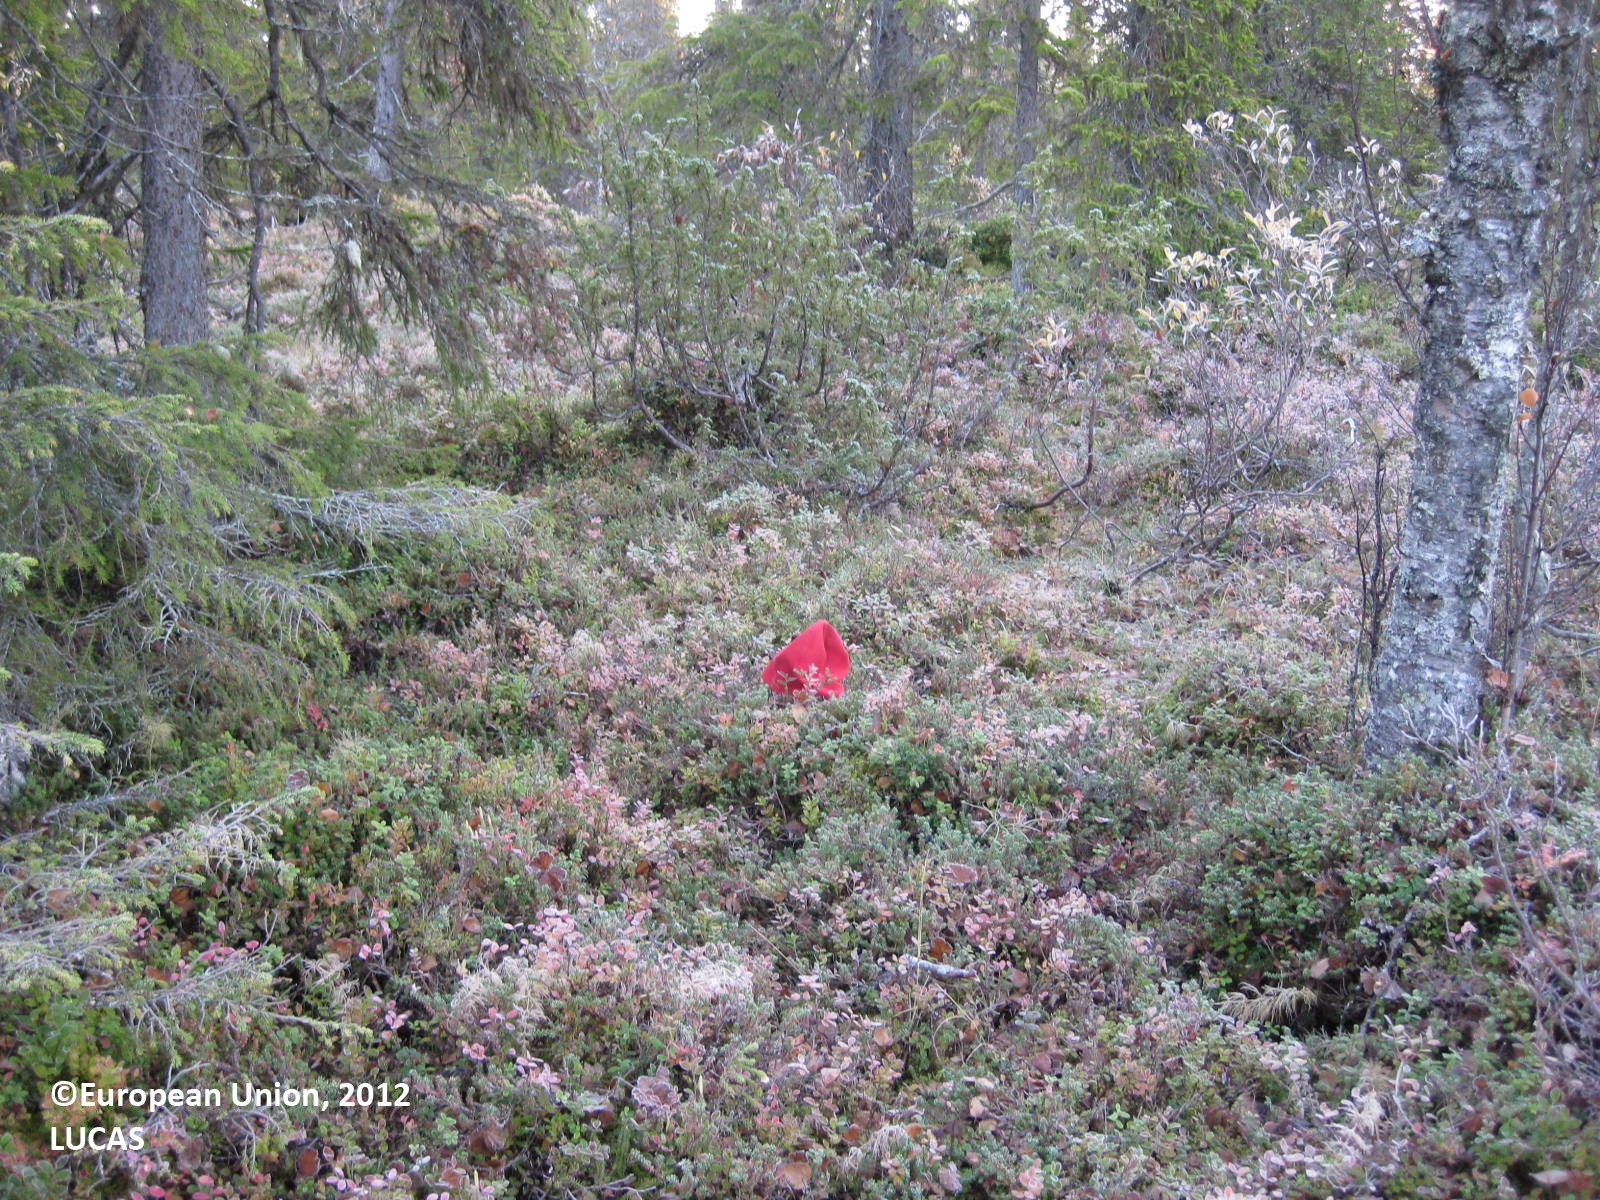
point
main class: Woodland
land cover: Spruce dominated coniferous woodland
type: boreal forest
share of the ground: 50 - 75 %
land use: Semi-natural and natural areas not in use
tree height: > 5 m
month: September
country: FI
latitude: 68.0290
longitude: 24.0756
